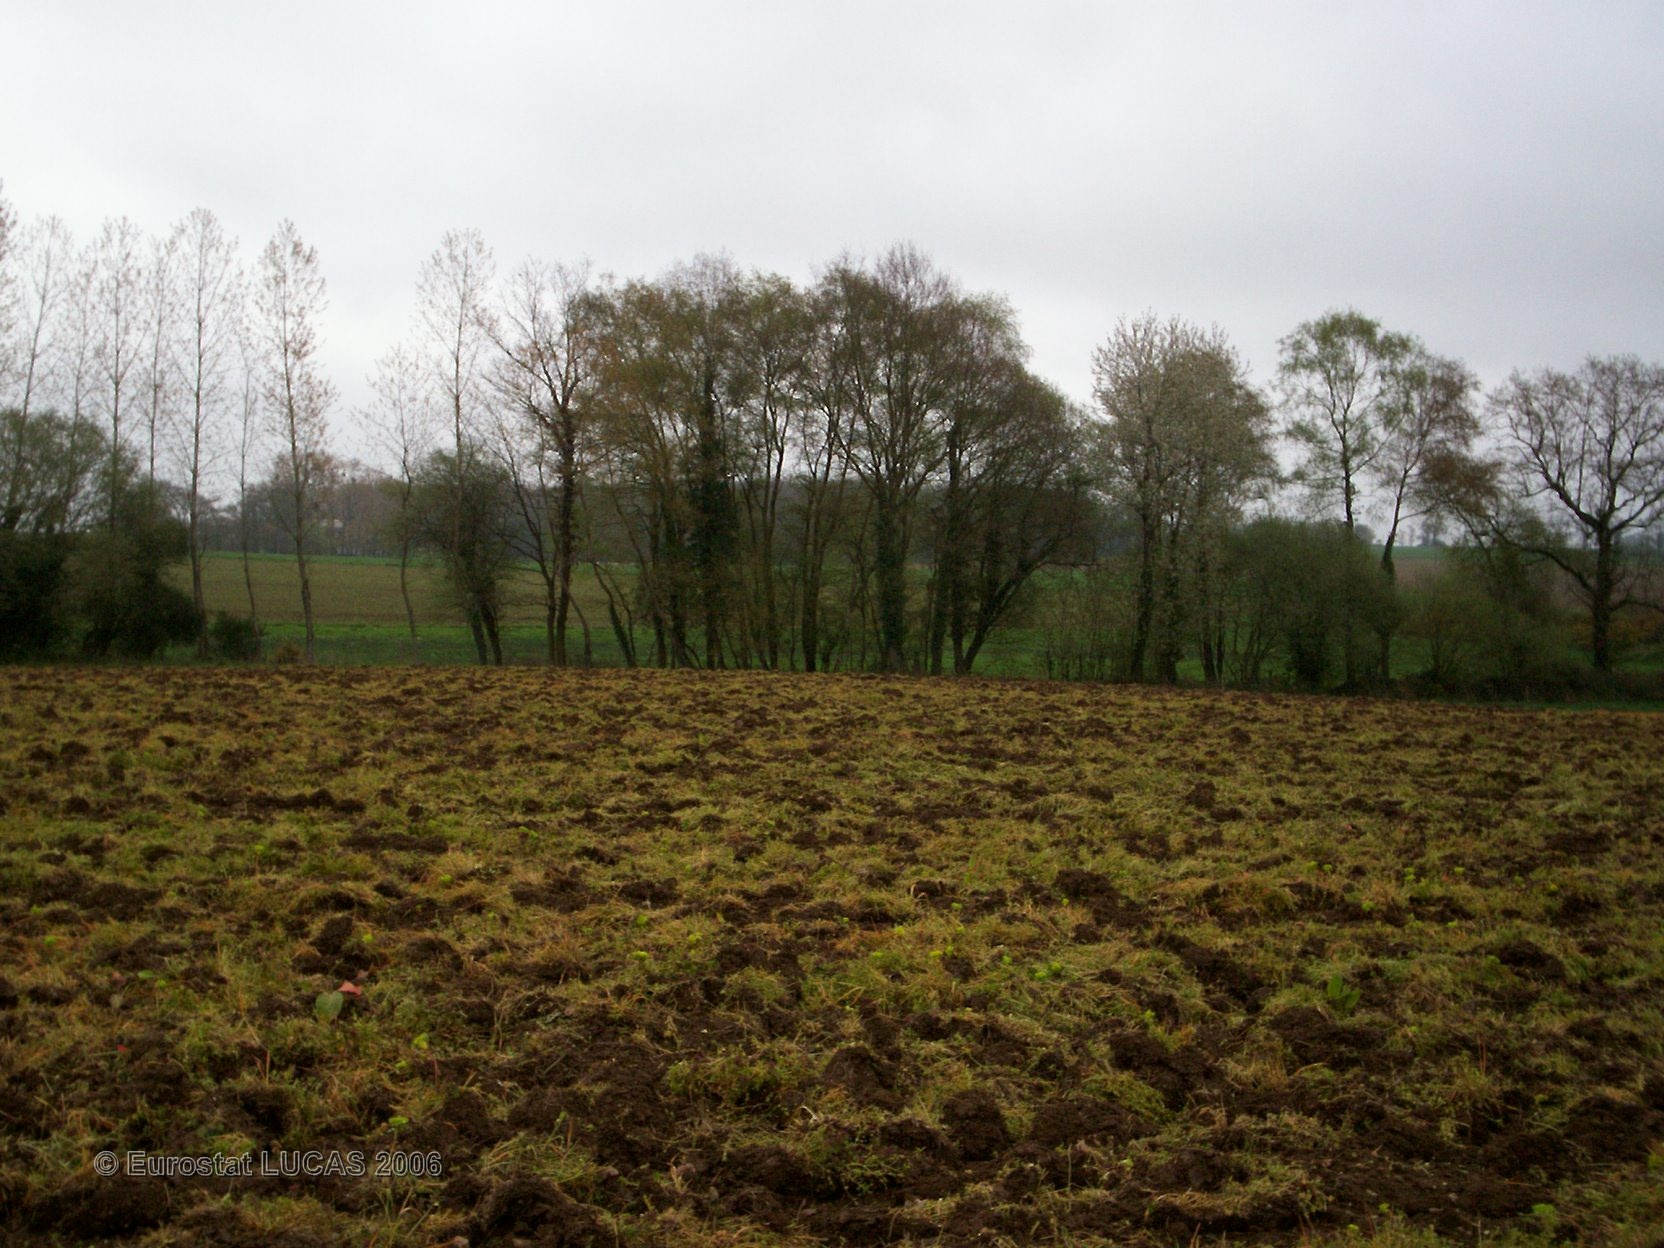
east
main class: Grassland
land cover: Grassland without tree/shrub cover
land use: Fallow land
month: June
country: FR
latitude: 48.0839
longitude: -2.7226
